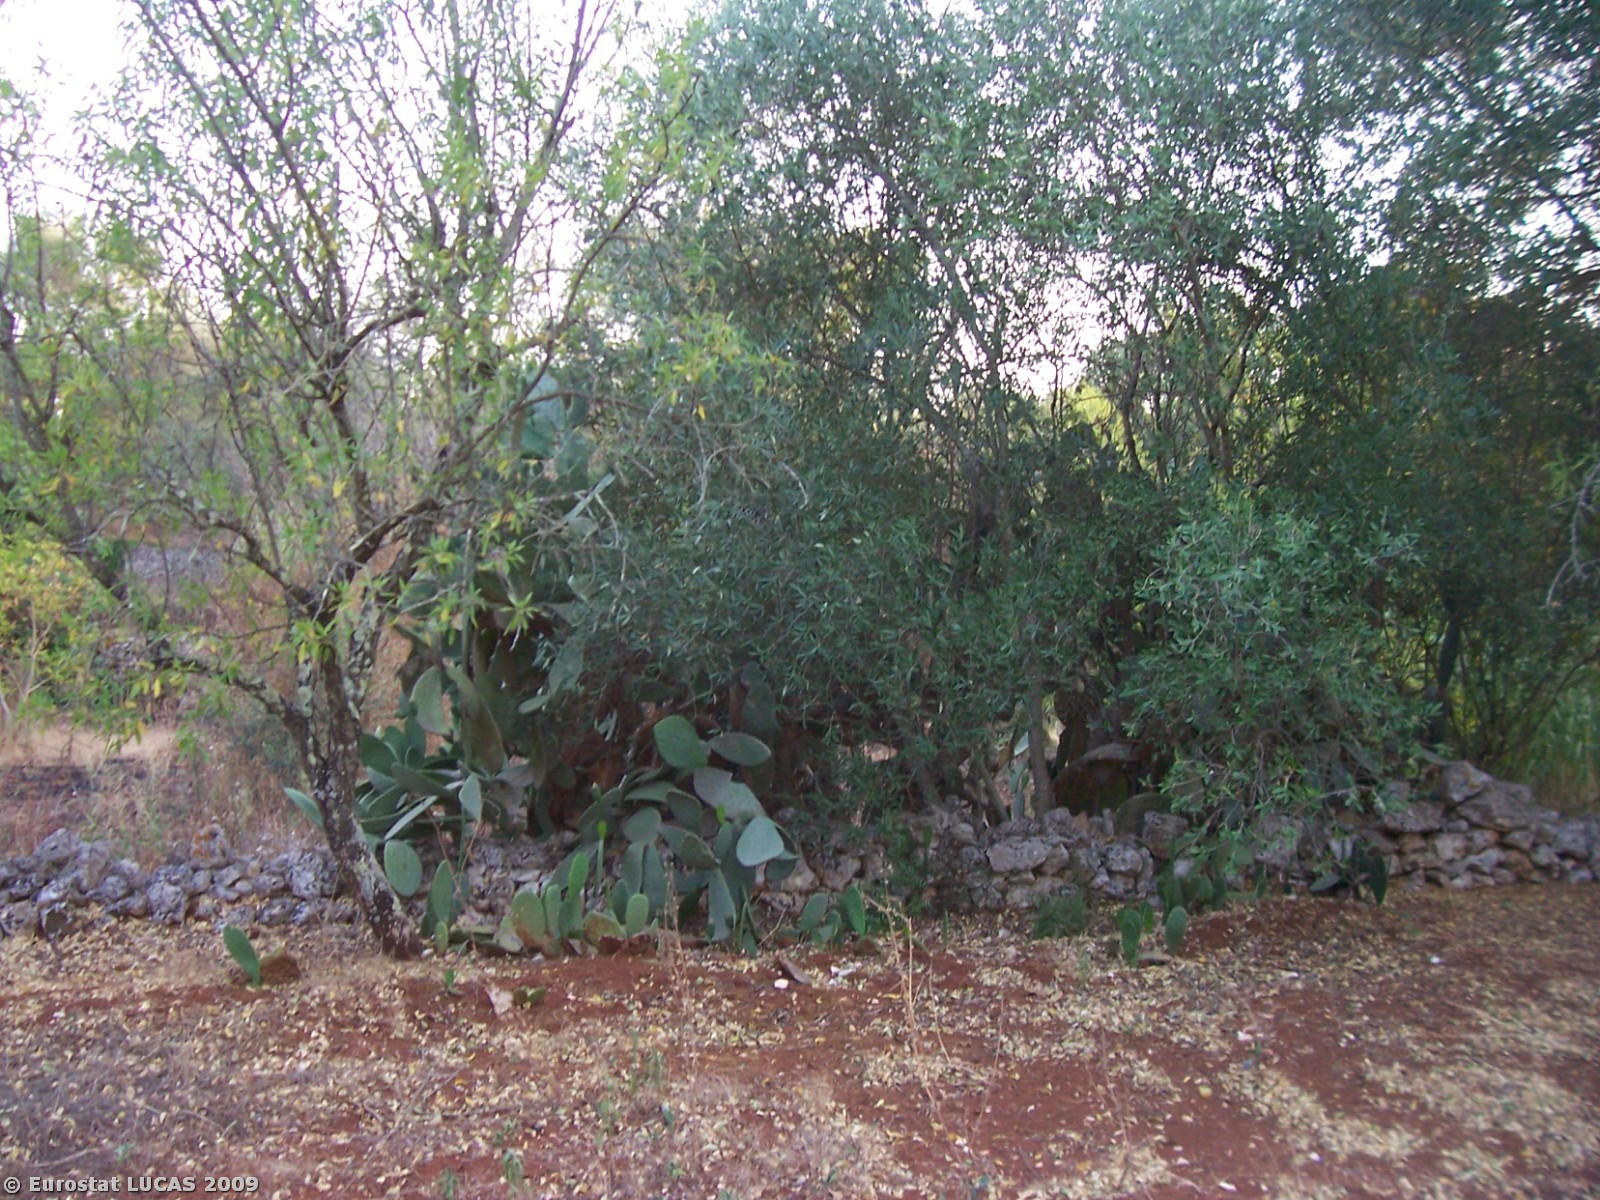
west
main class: Cropland
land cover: Nuts trees
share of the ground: 25 - 50 %
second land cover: Spontaneously vegetated surfaces
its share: > 75 %
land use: Agriculture (excluding fallow land and kitchen gardens)
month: July
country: IT
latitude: 40.6656
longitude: 17.5592
